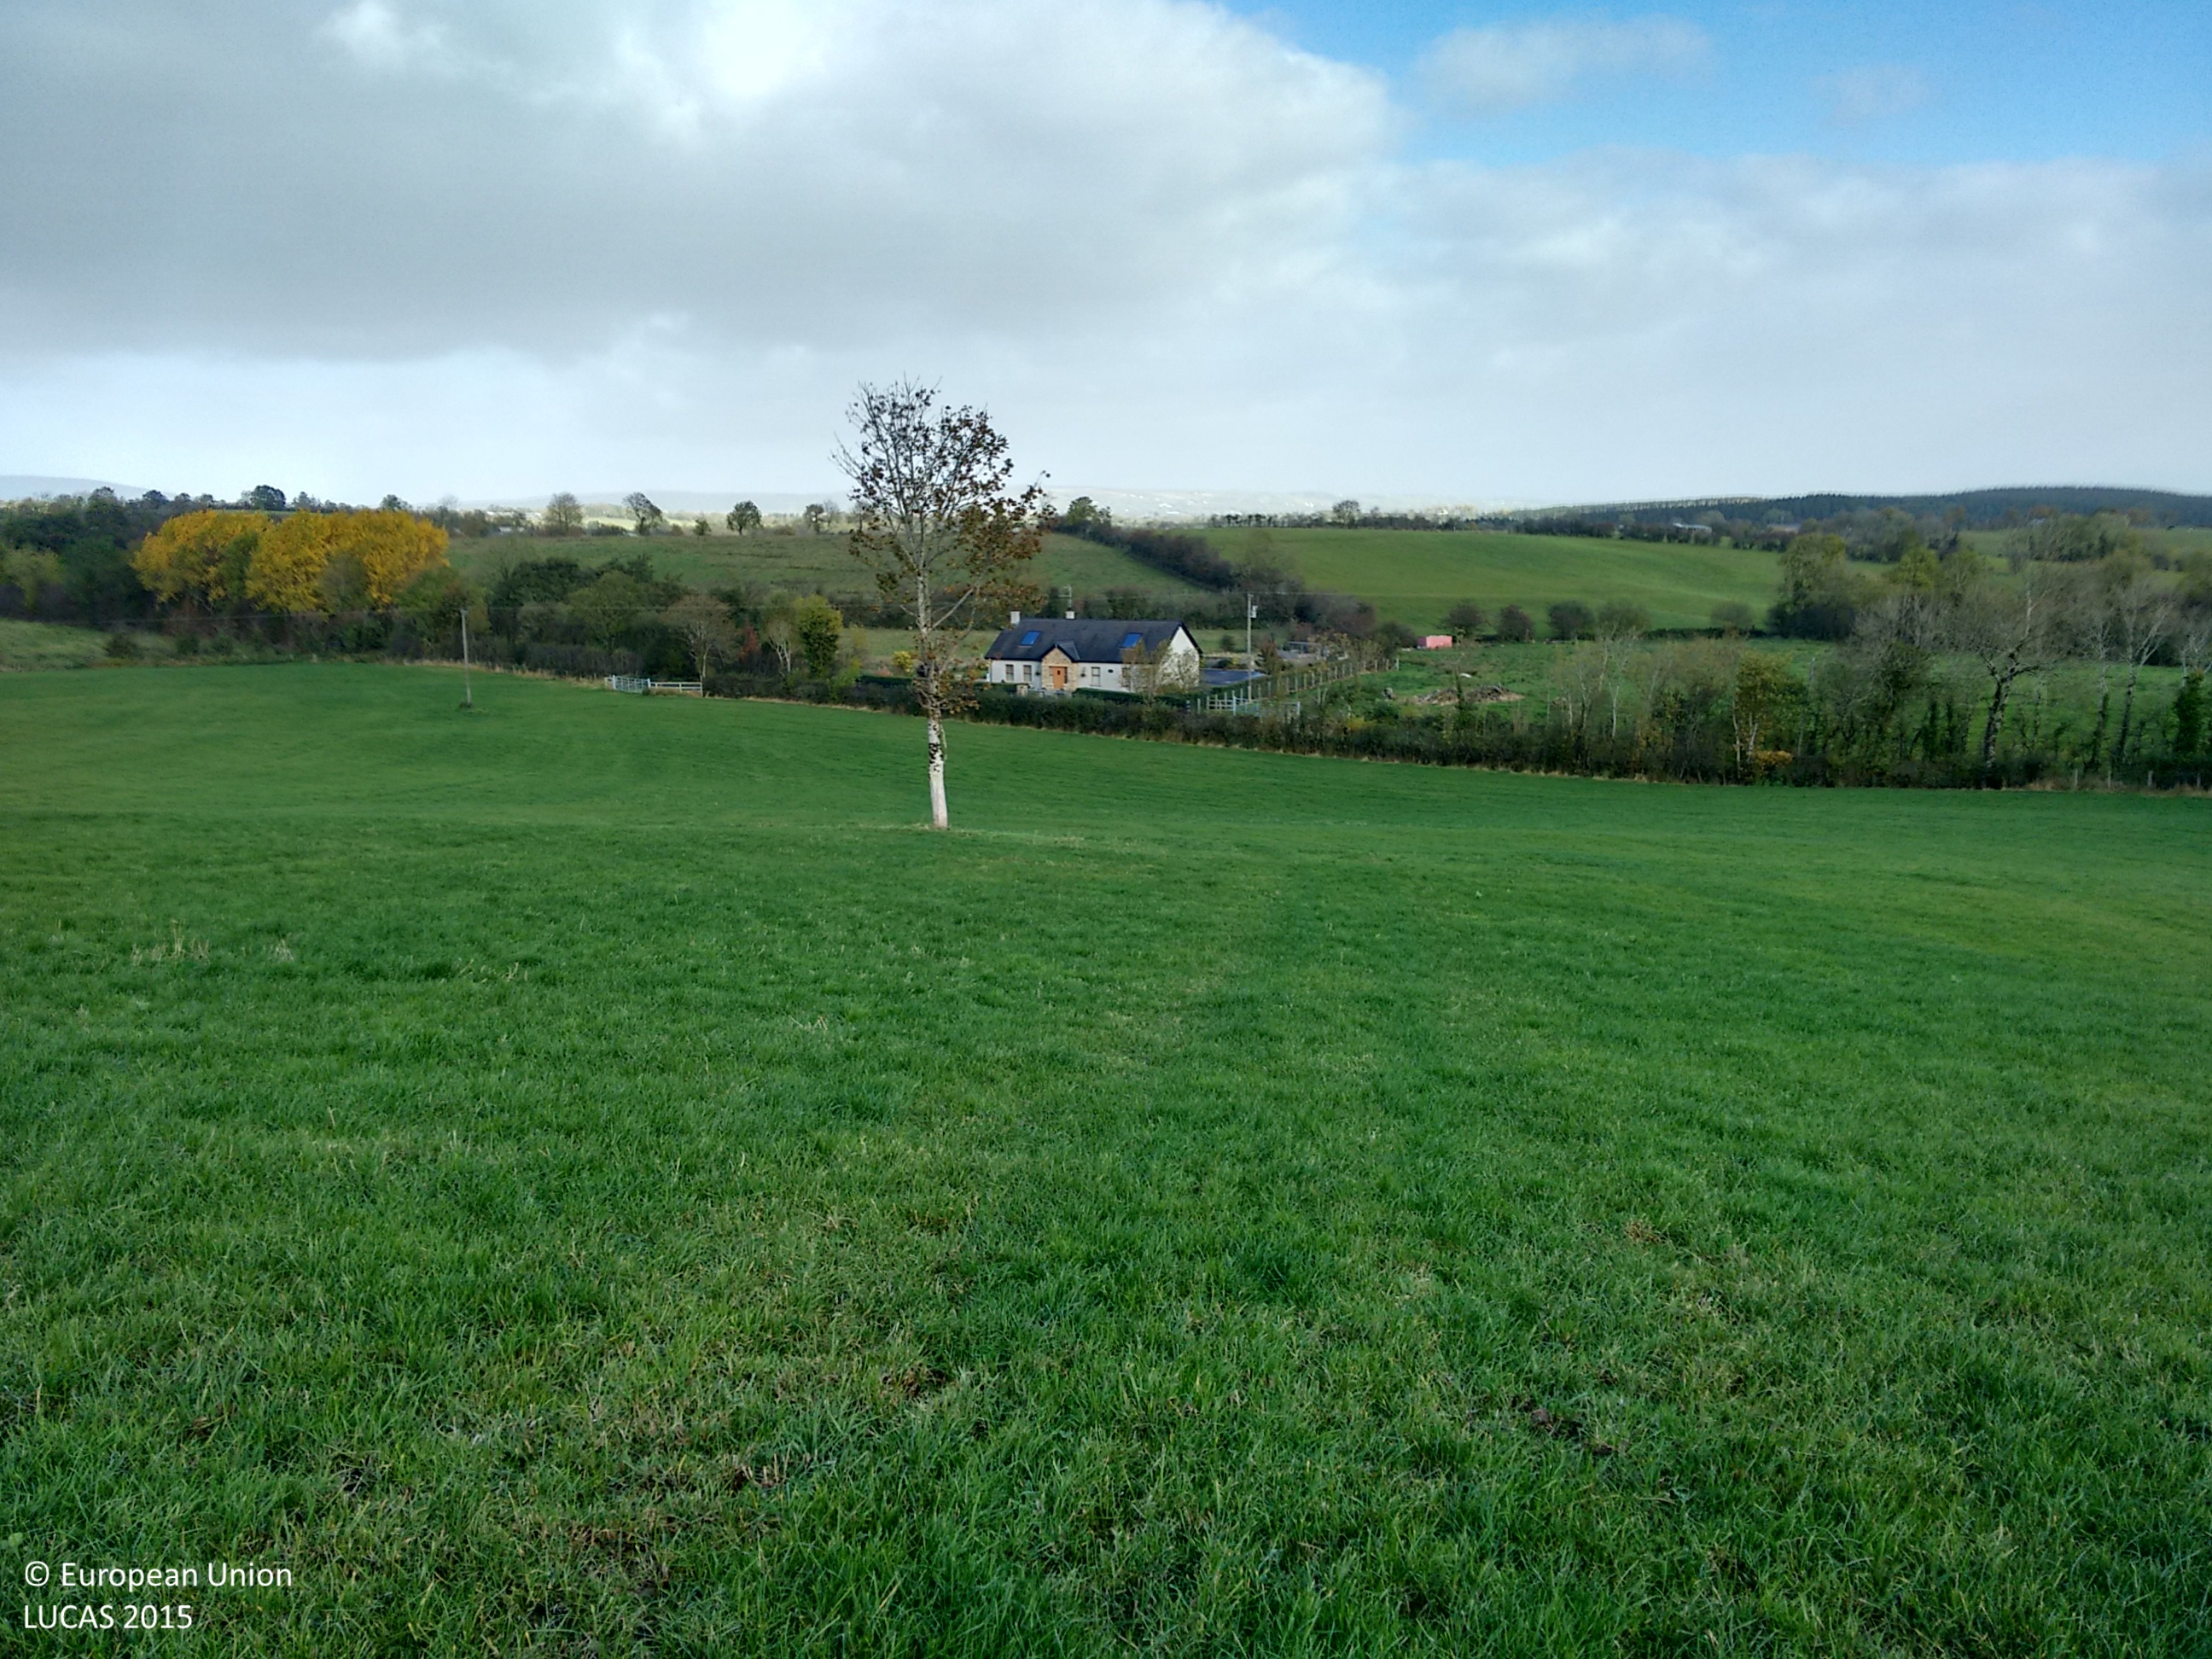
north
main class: Grassland
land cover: Grassland without tree/shrub cover
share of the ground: > 75 %
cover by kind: herbaceous plants 100 %
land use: Agriculture (excluding fallow land and kitchen gardens)
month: October
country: GB
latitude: 54.4830
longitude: -7.4251
